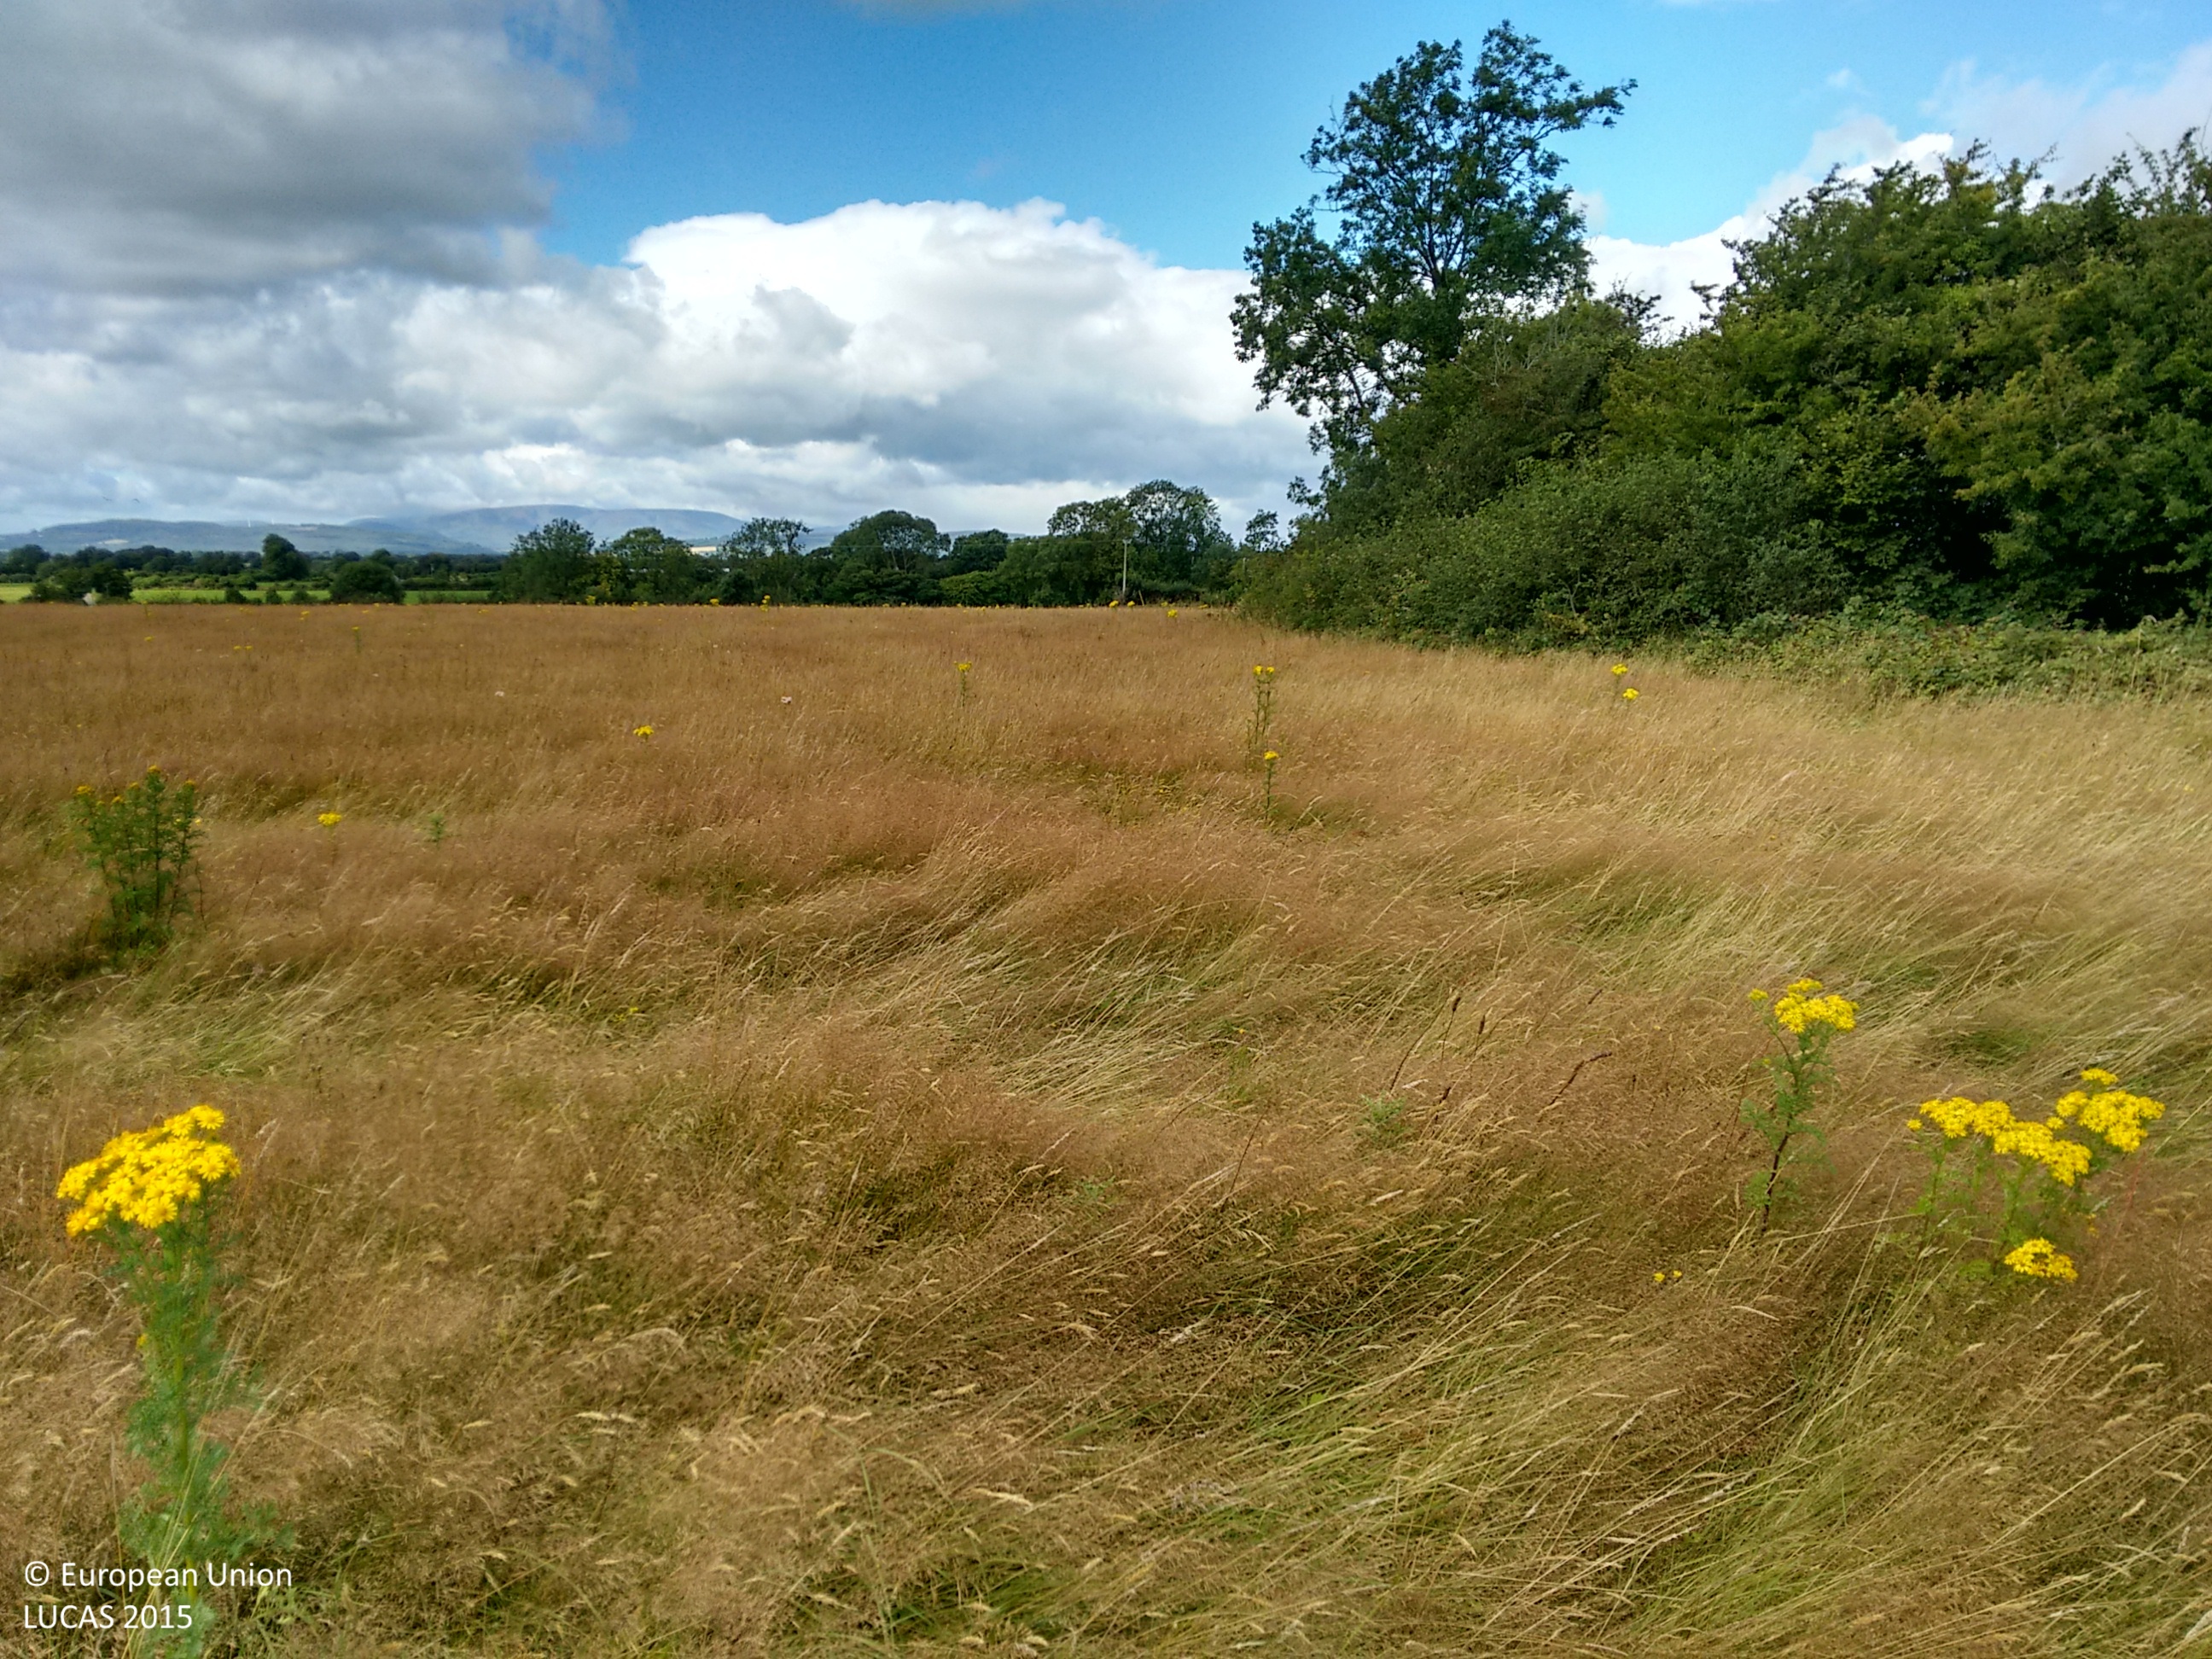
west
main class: Grassland
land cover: Grassland without tree/shrub cover
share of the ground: > 75 %
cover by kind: herbaceous plants 100 %
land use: Agriculture (excluding fallow land and kitchen gardens)
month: August
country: IE
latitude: 52.3254
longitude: -7.1837
